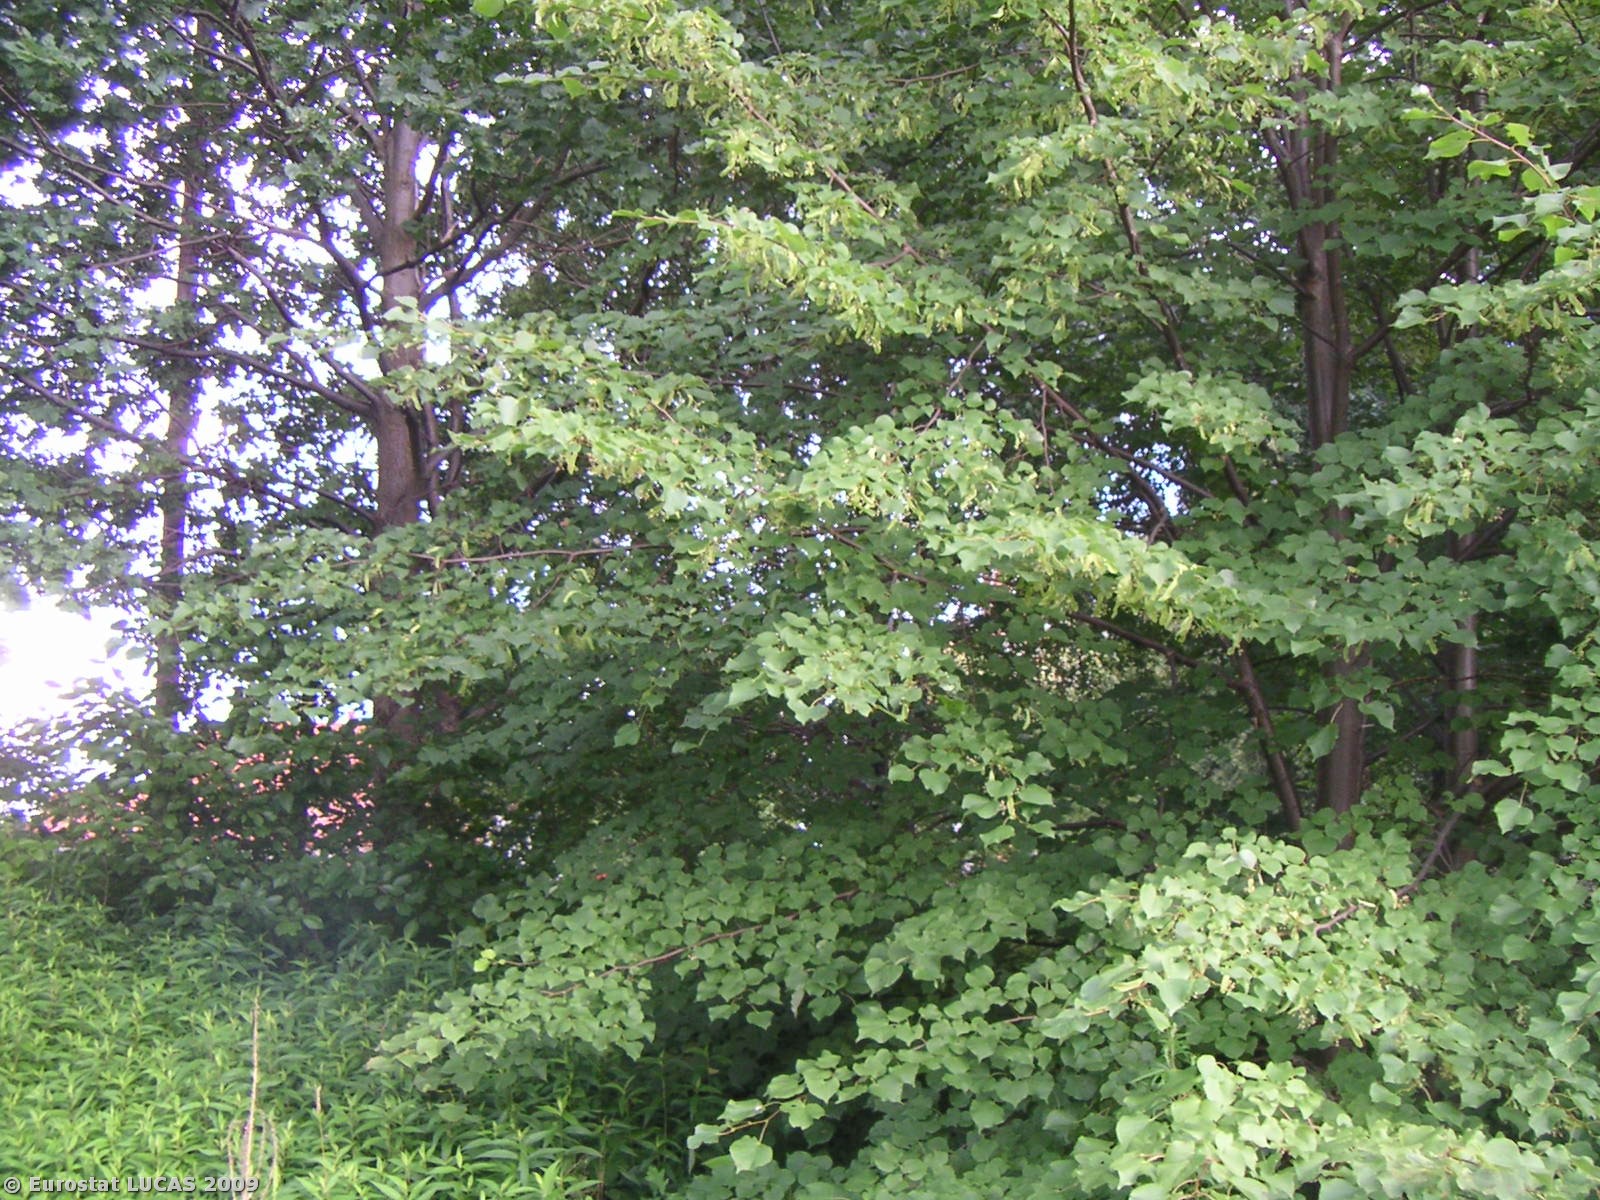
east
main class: Grassland
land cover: Grassland with sparse tree/shrub cover
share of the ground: > 75 %
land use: Agriculture (excluding fallow land and kitchen gardens)
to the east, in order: Grassland with sparse tree/shrub cover; Broadleaved woodland; Artificial constructions in urban areas; Paved roads, cycling and walking lanes; Grass margins; Electric lines; Fences; Grassland without tree/shrub cover
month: July
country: PL
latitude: 50.0821
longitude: 18.7553
